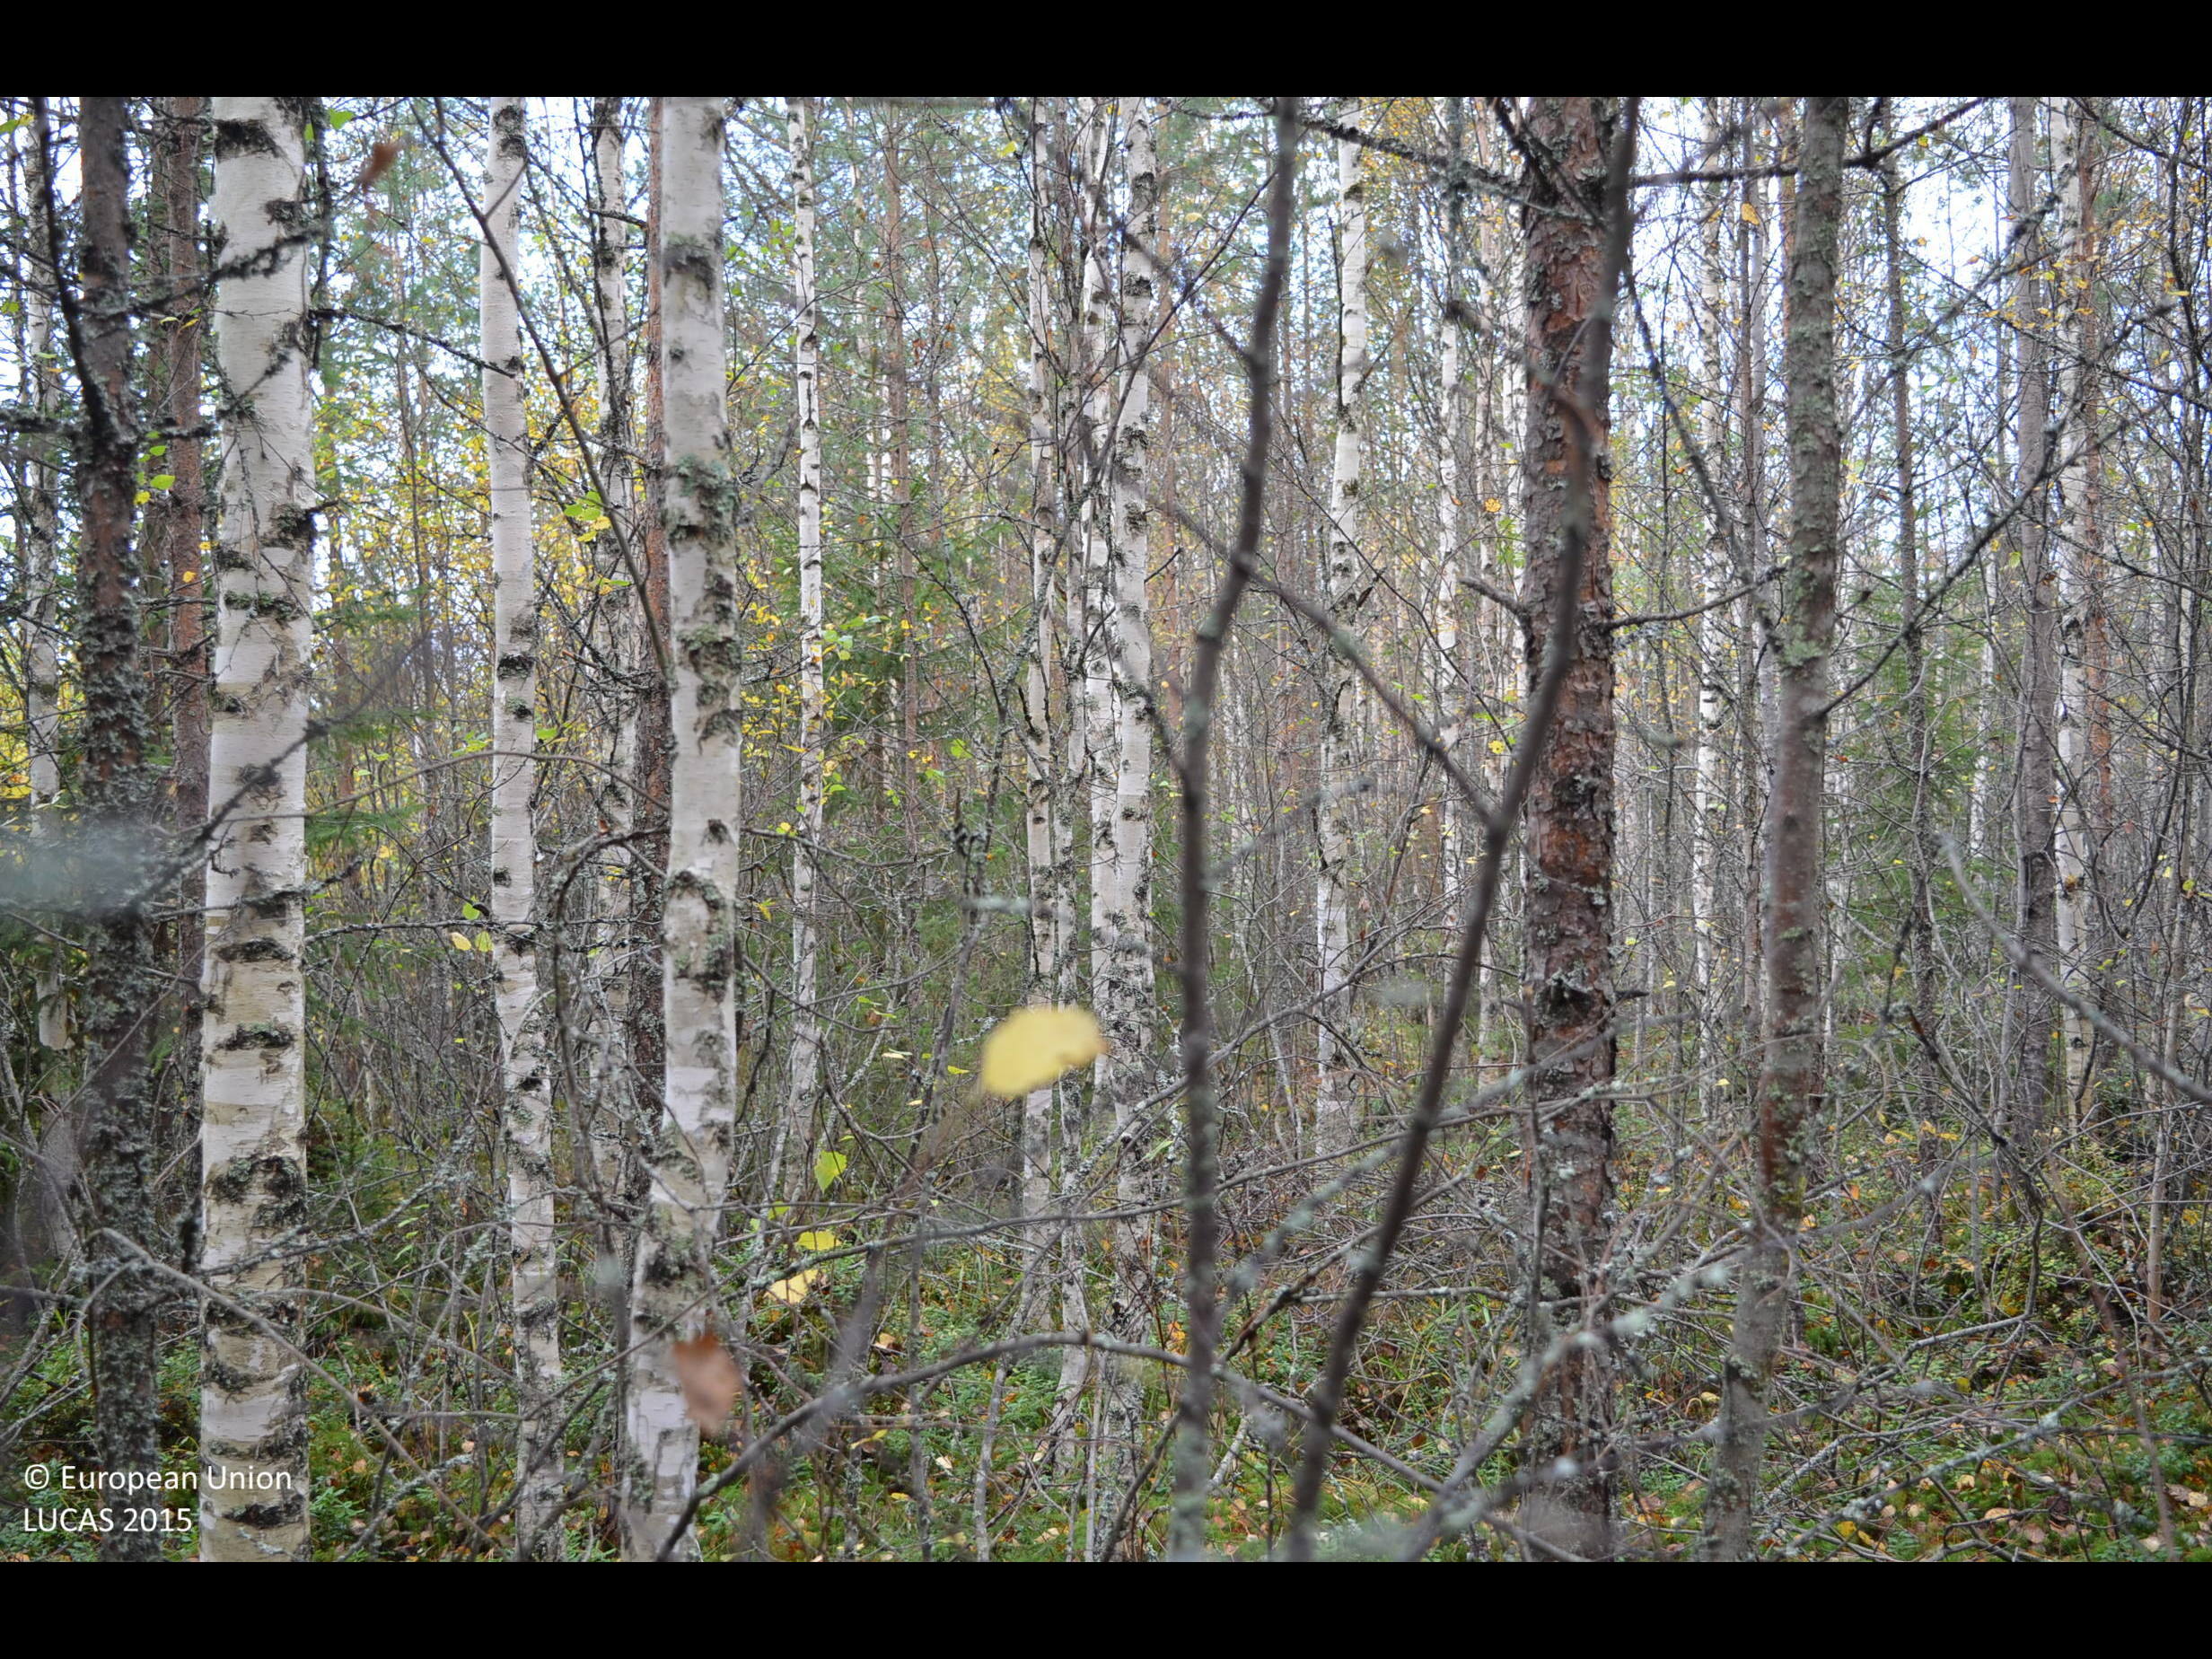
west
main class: Woodland
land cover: Pine dominated mixed woodland
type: boreal forest
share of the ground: > 75 %
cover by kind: broadleaved forest trees 50 %, coniferous forest trees 40 %, shrubs 5 %, lichens and mosses 5 %
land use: Forestry
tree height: > 5 m
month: September
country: FI
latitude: 62.5365
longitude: 23.6595
